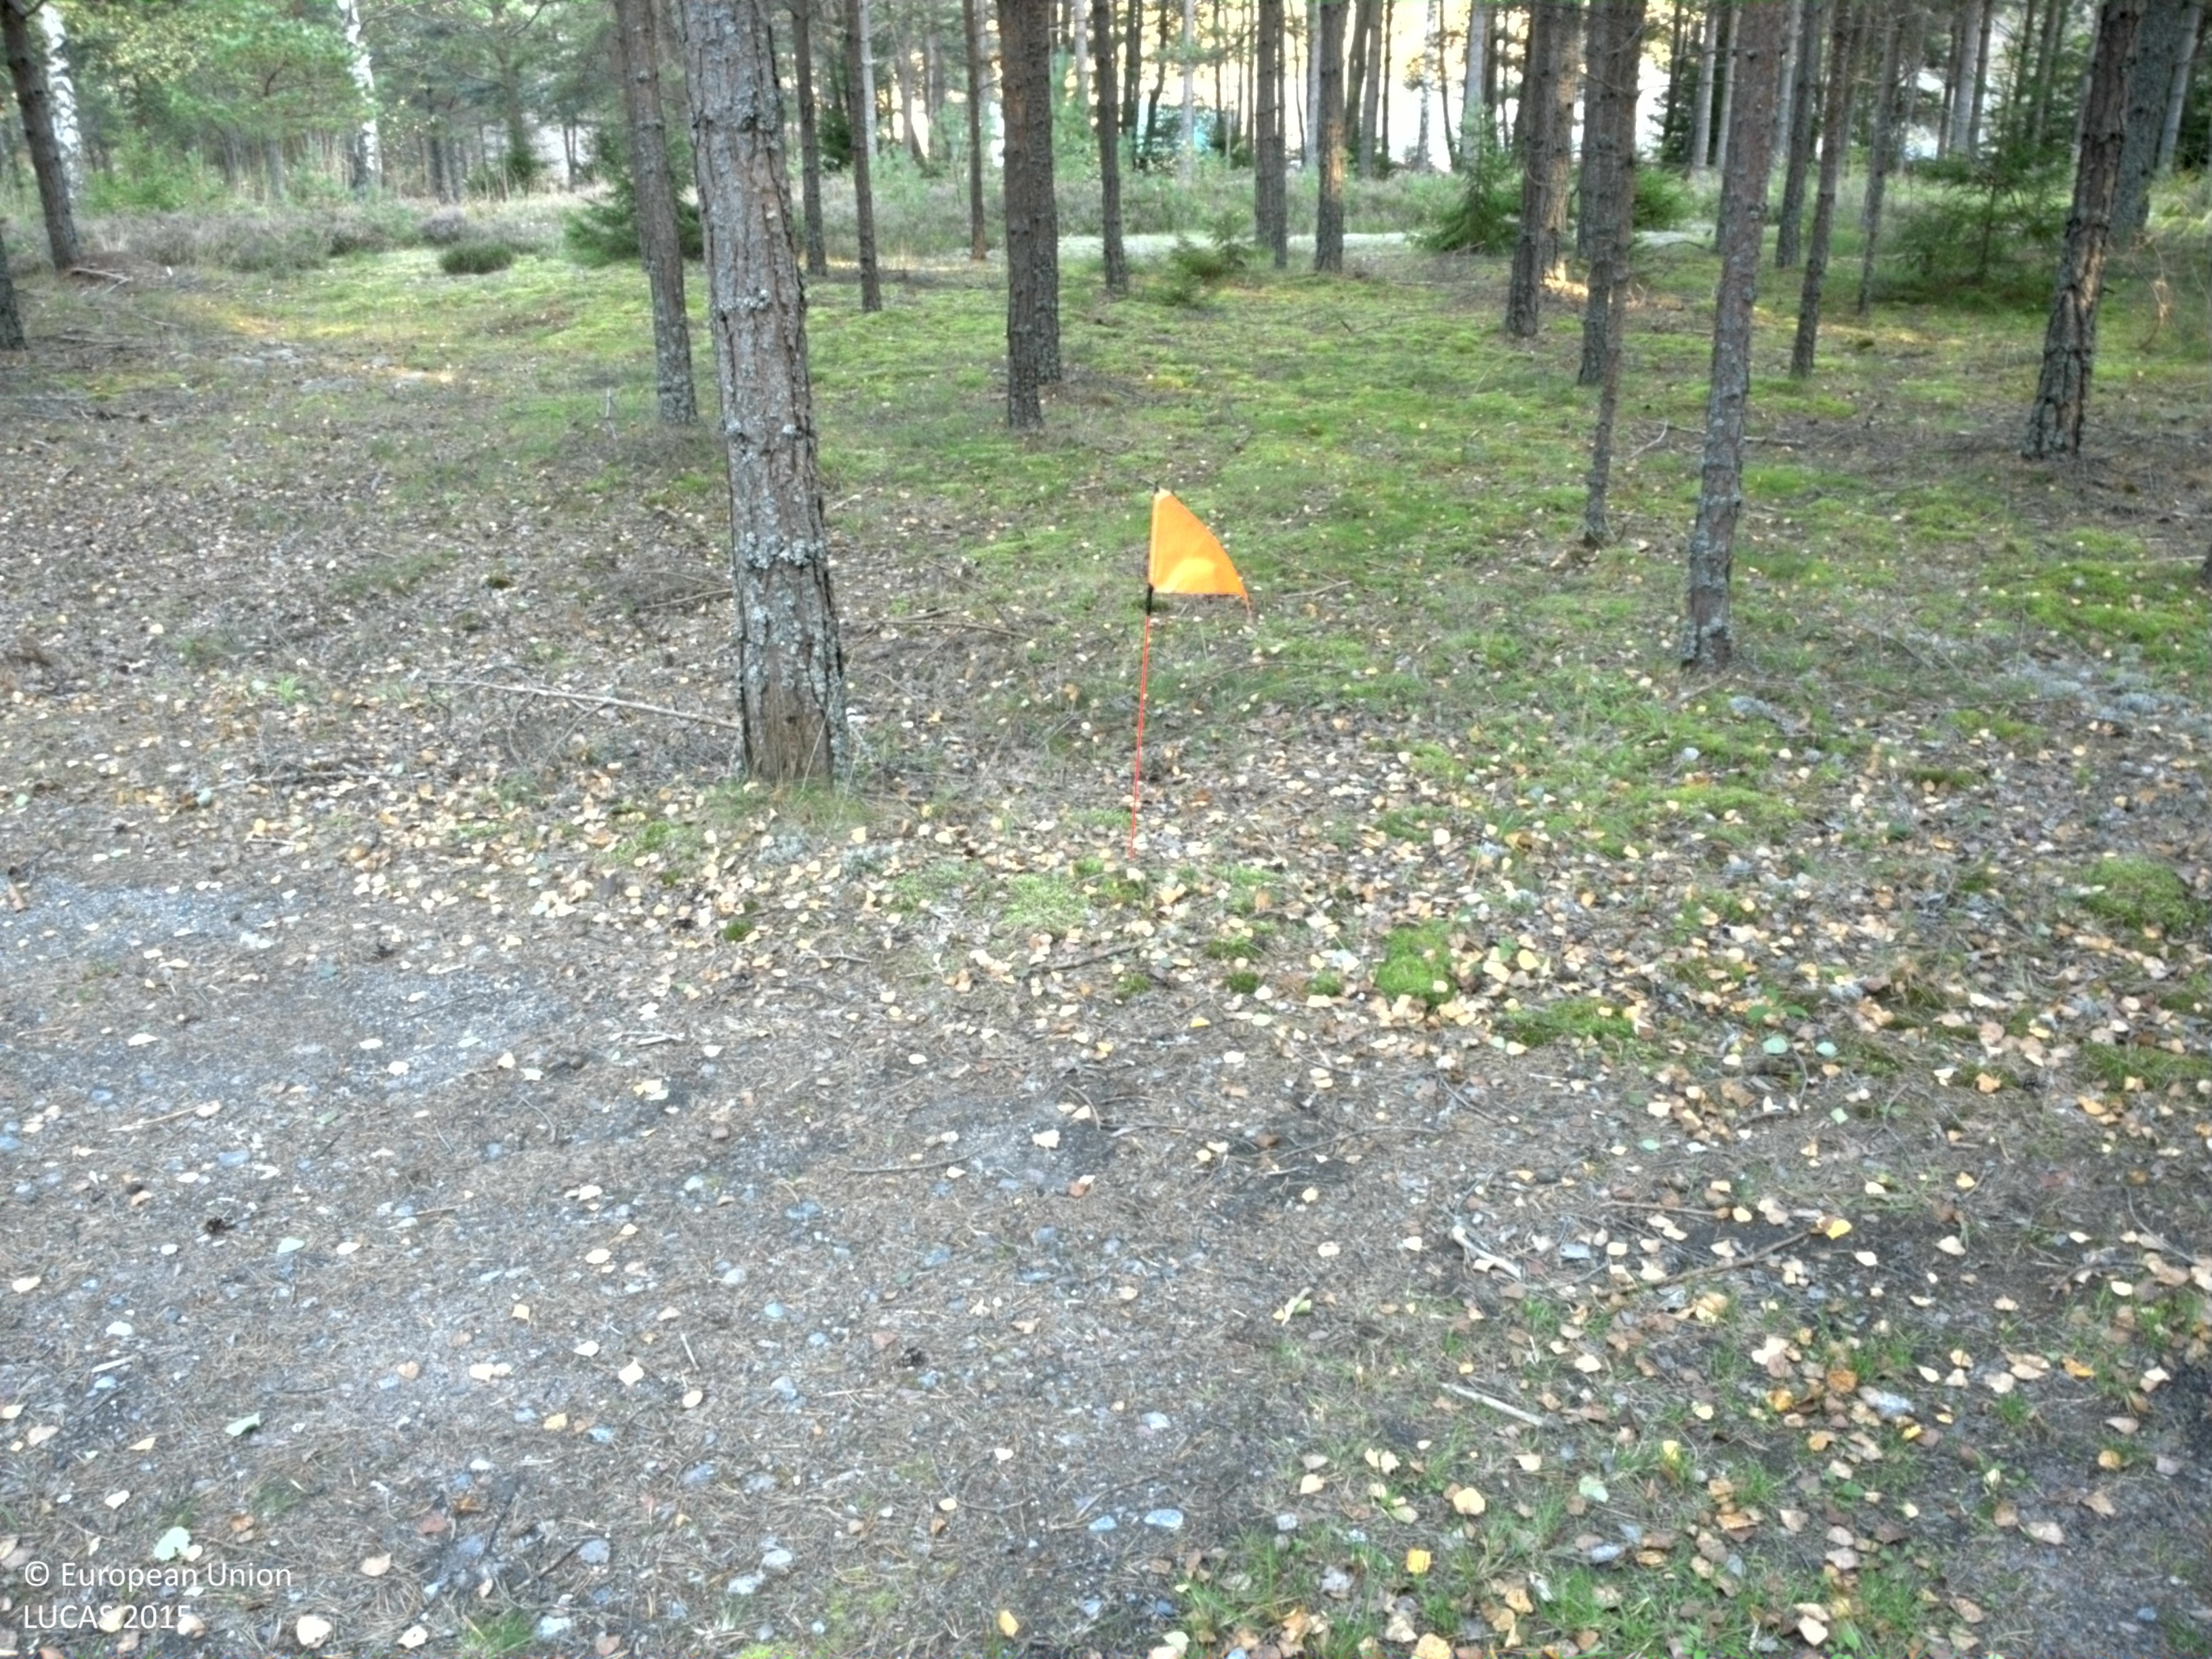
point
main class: Woodland
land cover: Pine dominated coniferous woodland
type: boreal forest
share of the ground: 50 - 75 %
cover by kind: coniferous forest trees 60 %, lichens and mosses 25 %, broadleaved forest trees 10 %, unconsolidated bare surface 5 %
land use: Amenities, museums, leisure
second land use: Sport
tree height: > 5 m
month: September
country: SE
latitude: 59.2959
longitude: 18.6937
